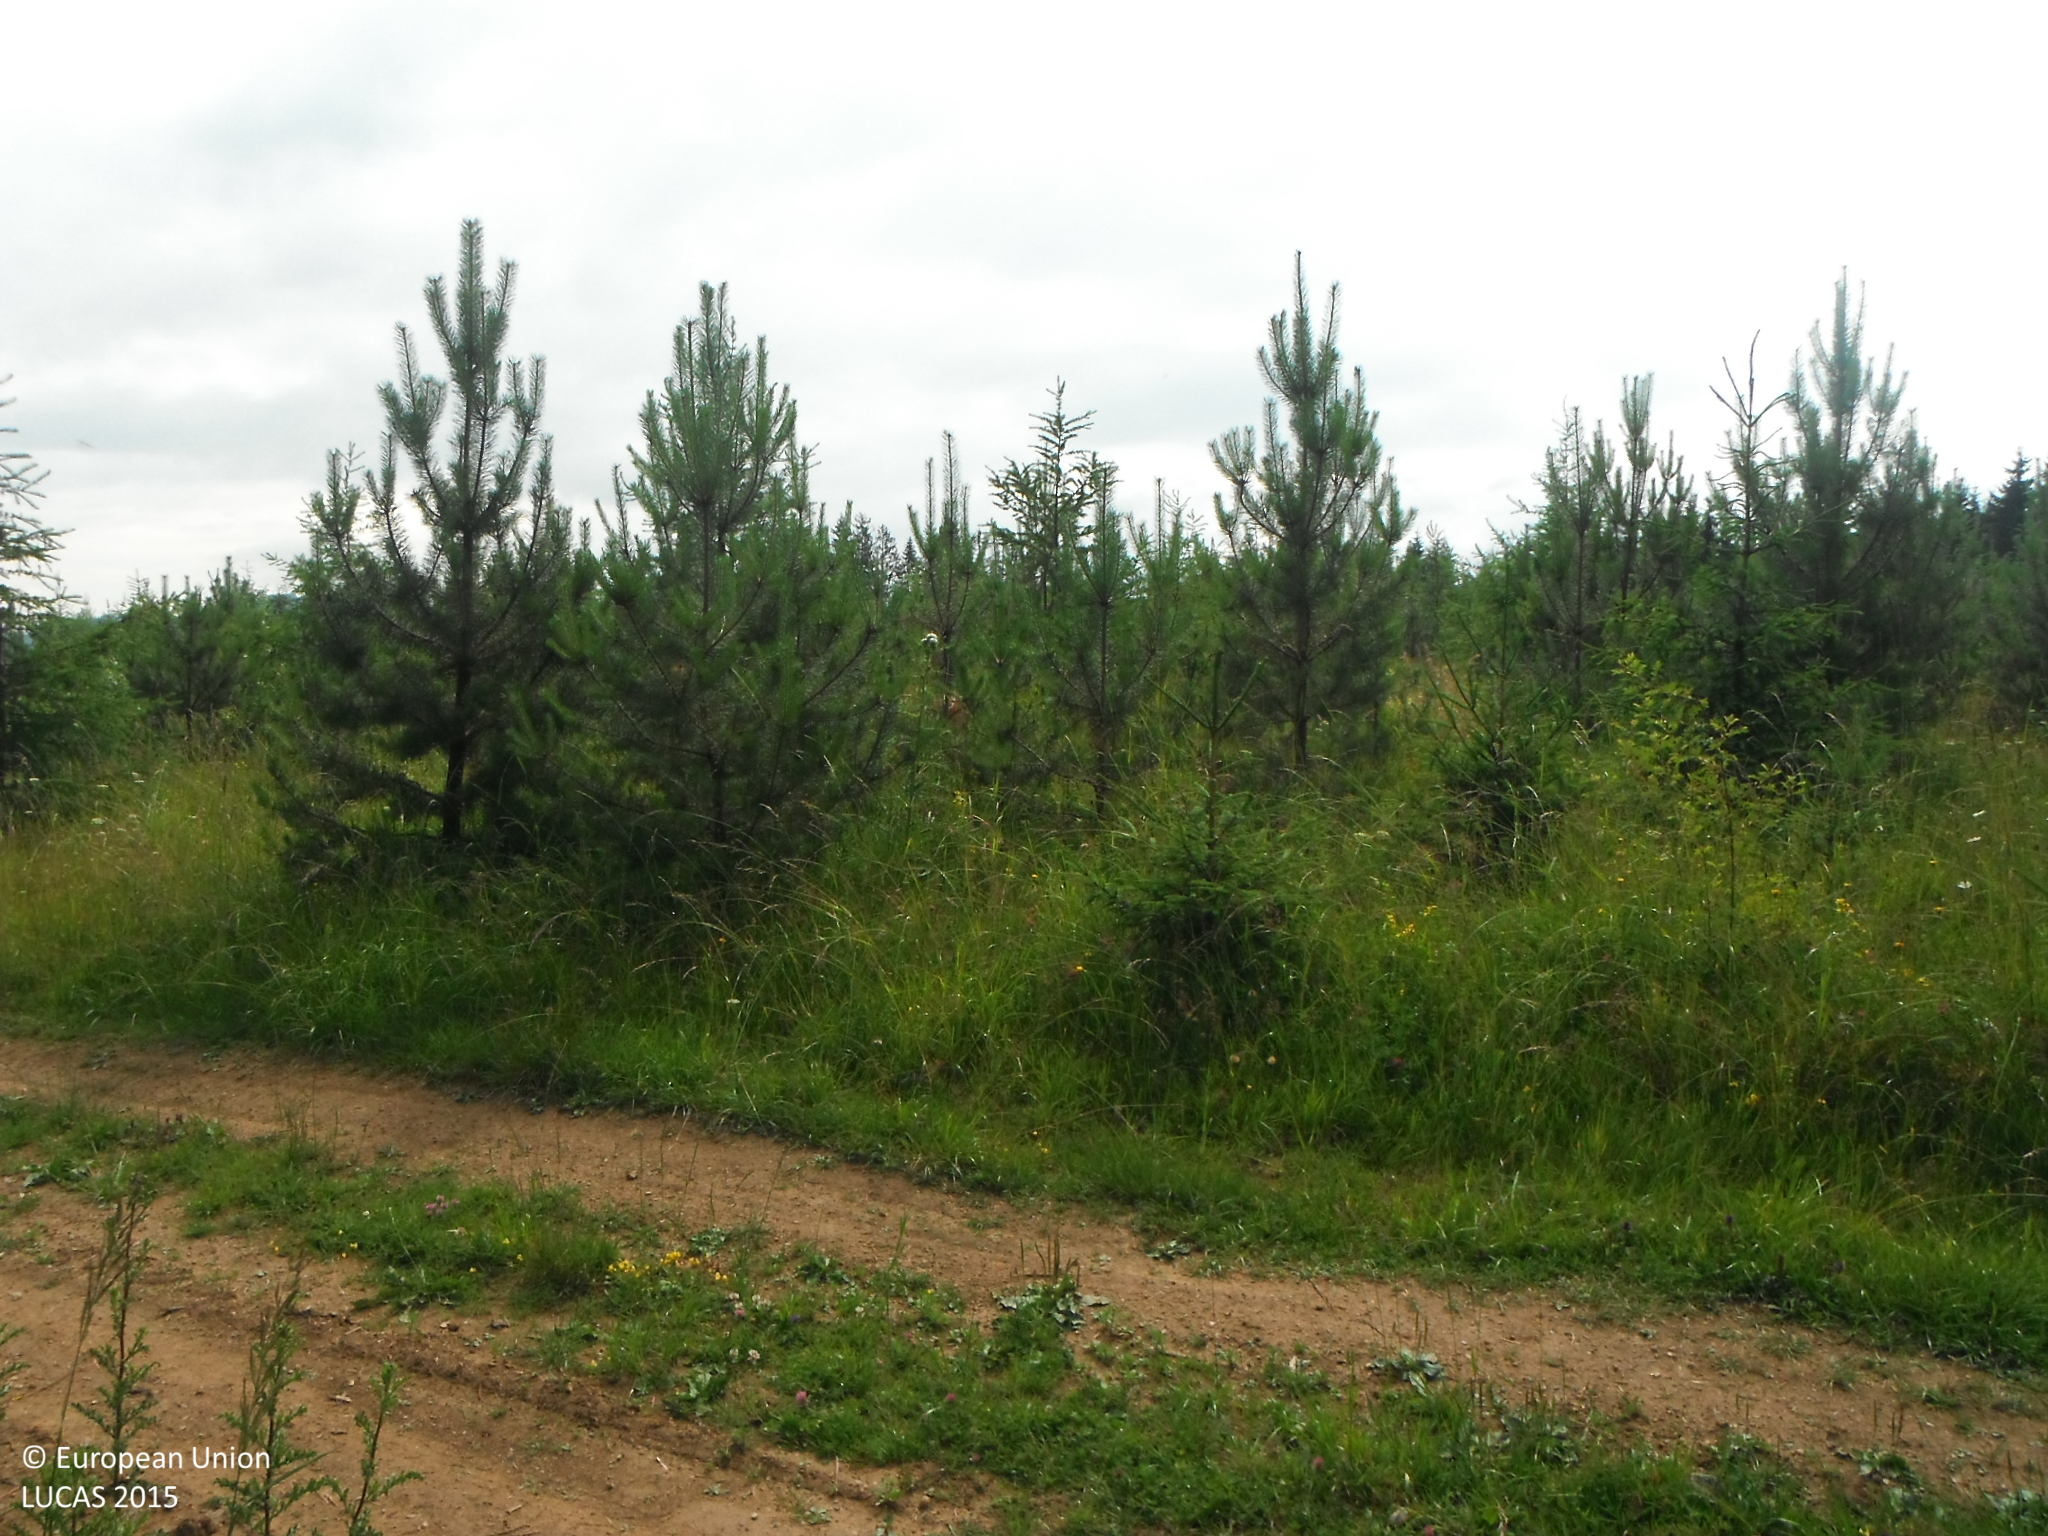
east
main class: Woodland
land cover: Other mixed woodland
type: hemiboreal forest and nemoral coniferous forest and mixed broadleaved-coniferous forest
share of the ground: 25 - 50 %
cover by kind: herbaceous plants 45 %, coniferous forest trees 25 %, broadleaved forest trees 20 %, consolidated bare surface 10 %
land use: Forestry
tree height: > 5 m
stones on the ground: > 50 %
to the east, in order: Other mixed woodland; Shrubland with sparse tree cover; Tracks; Pine dominated coniferous woodland; Grassland without tree/shrub cover; Tracks; Grassland without tree/shrub cover
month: July
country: SK
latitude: 49.0113
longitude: 20.0804
